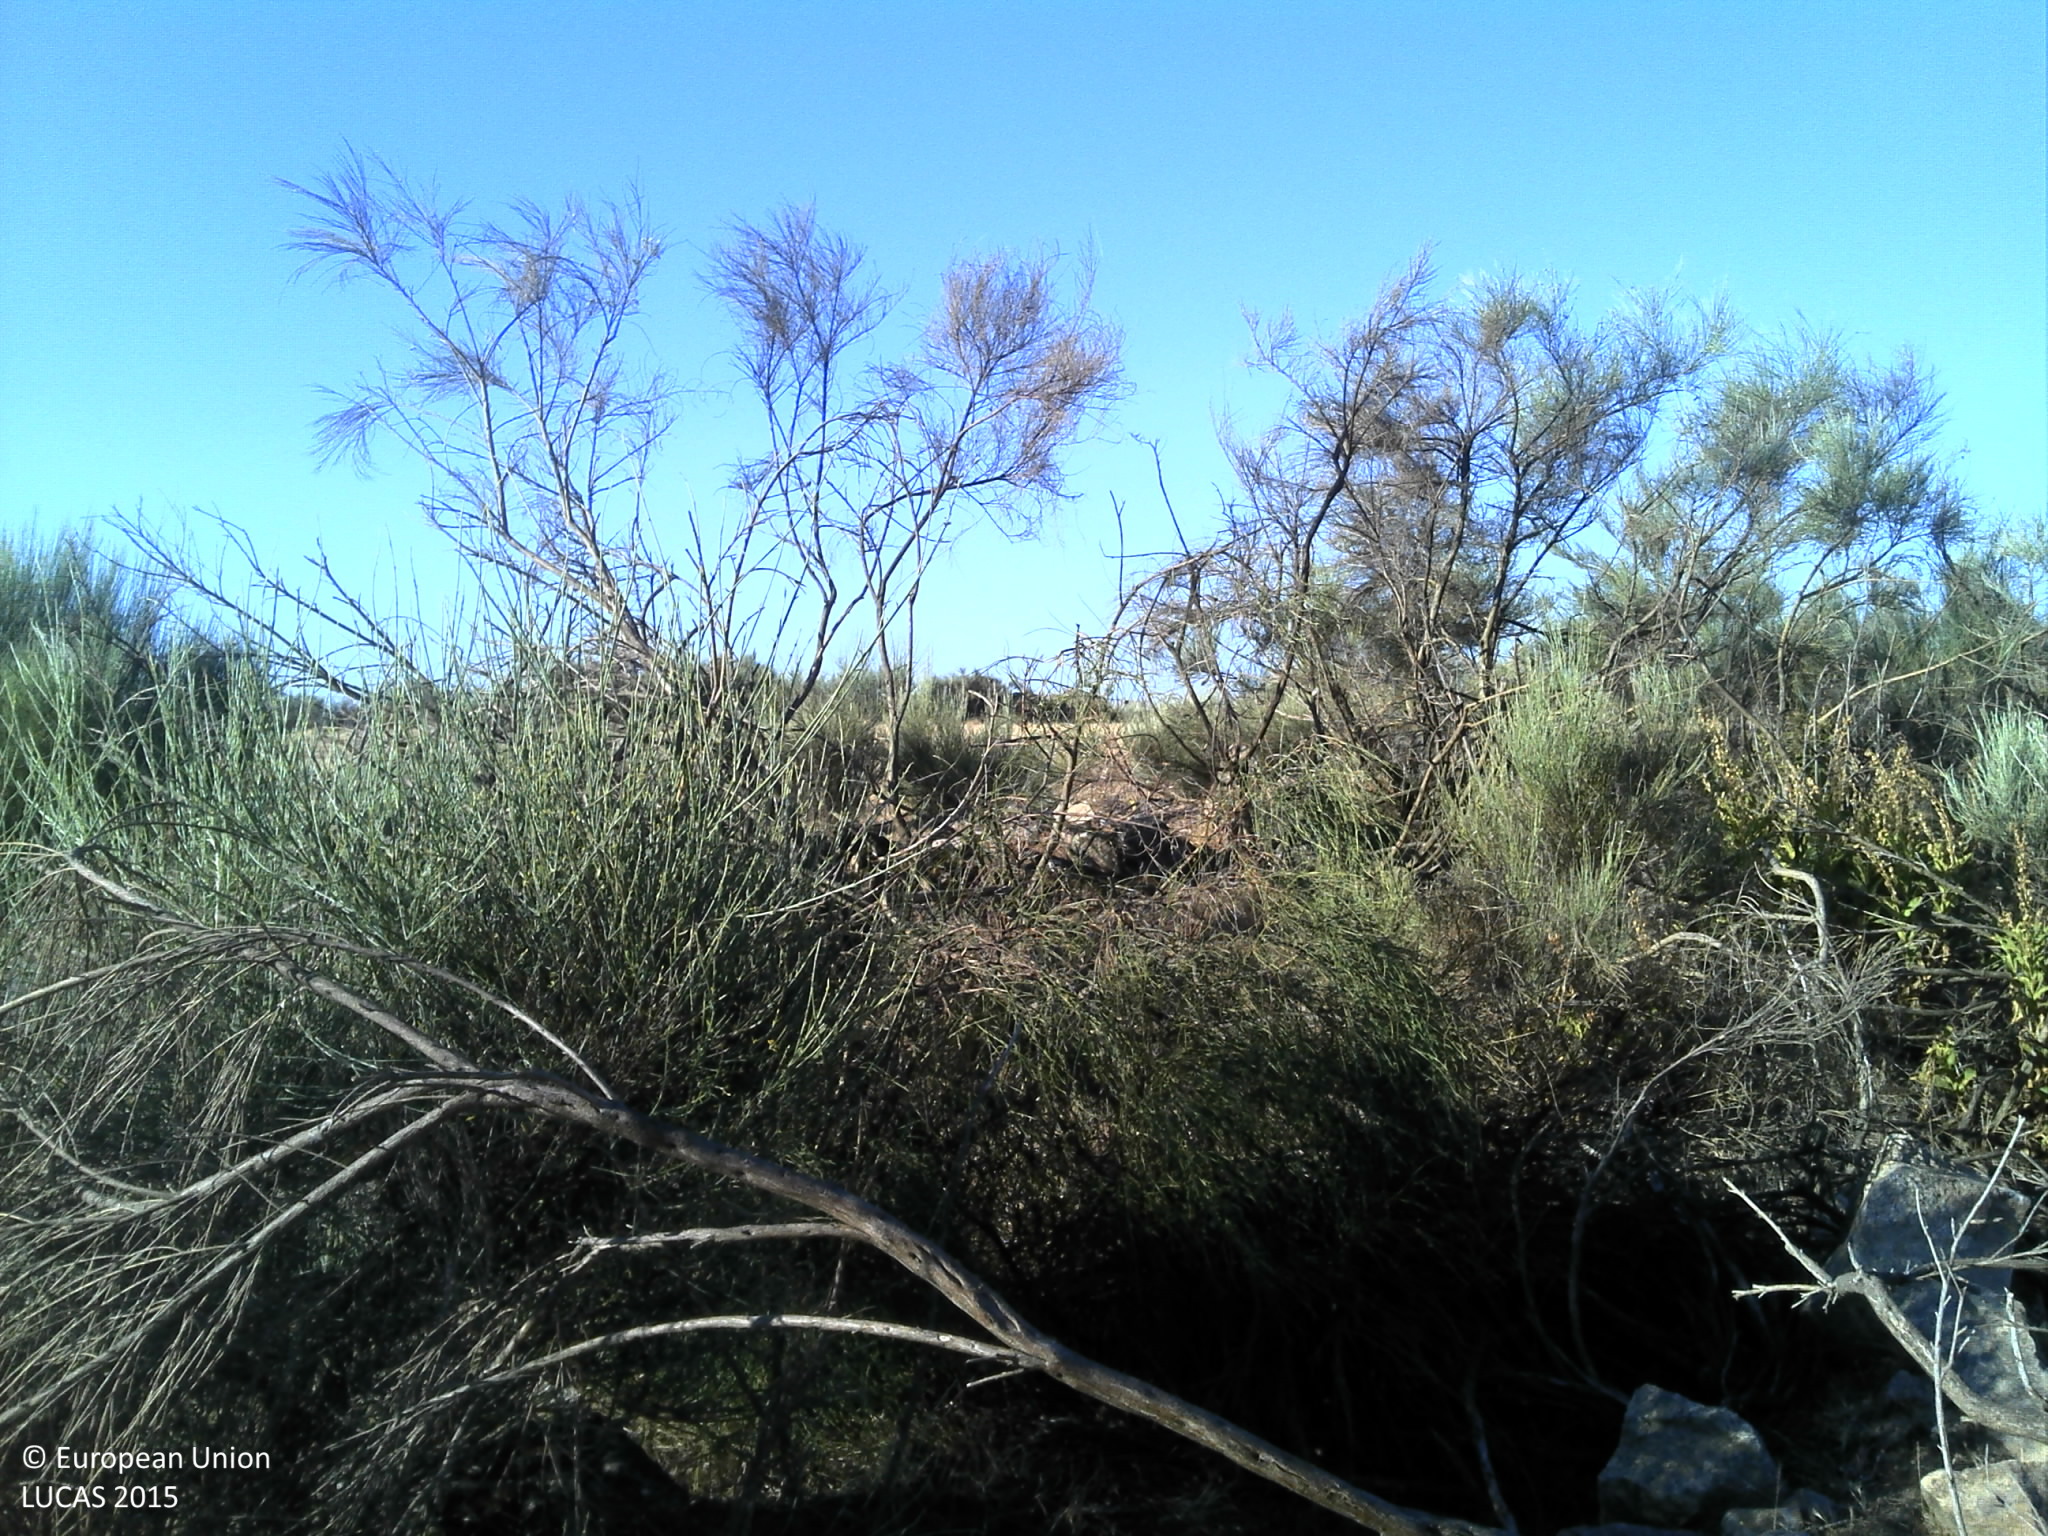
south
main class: Shrubland
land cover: Shrubland without tree cover
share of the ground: 50 - 75 %
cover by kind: shrubs 70 %, herbaceous plants 10 %, unconsolidated bare surface 10 %
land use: Agriculture (excluding fallow land and kitchen gardens)
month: June
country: PT
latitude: 40.1131
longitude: -7.3356
